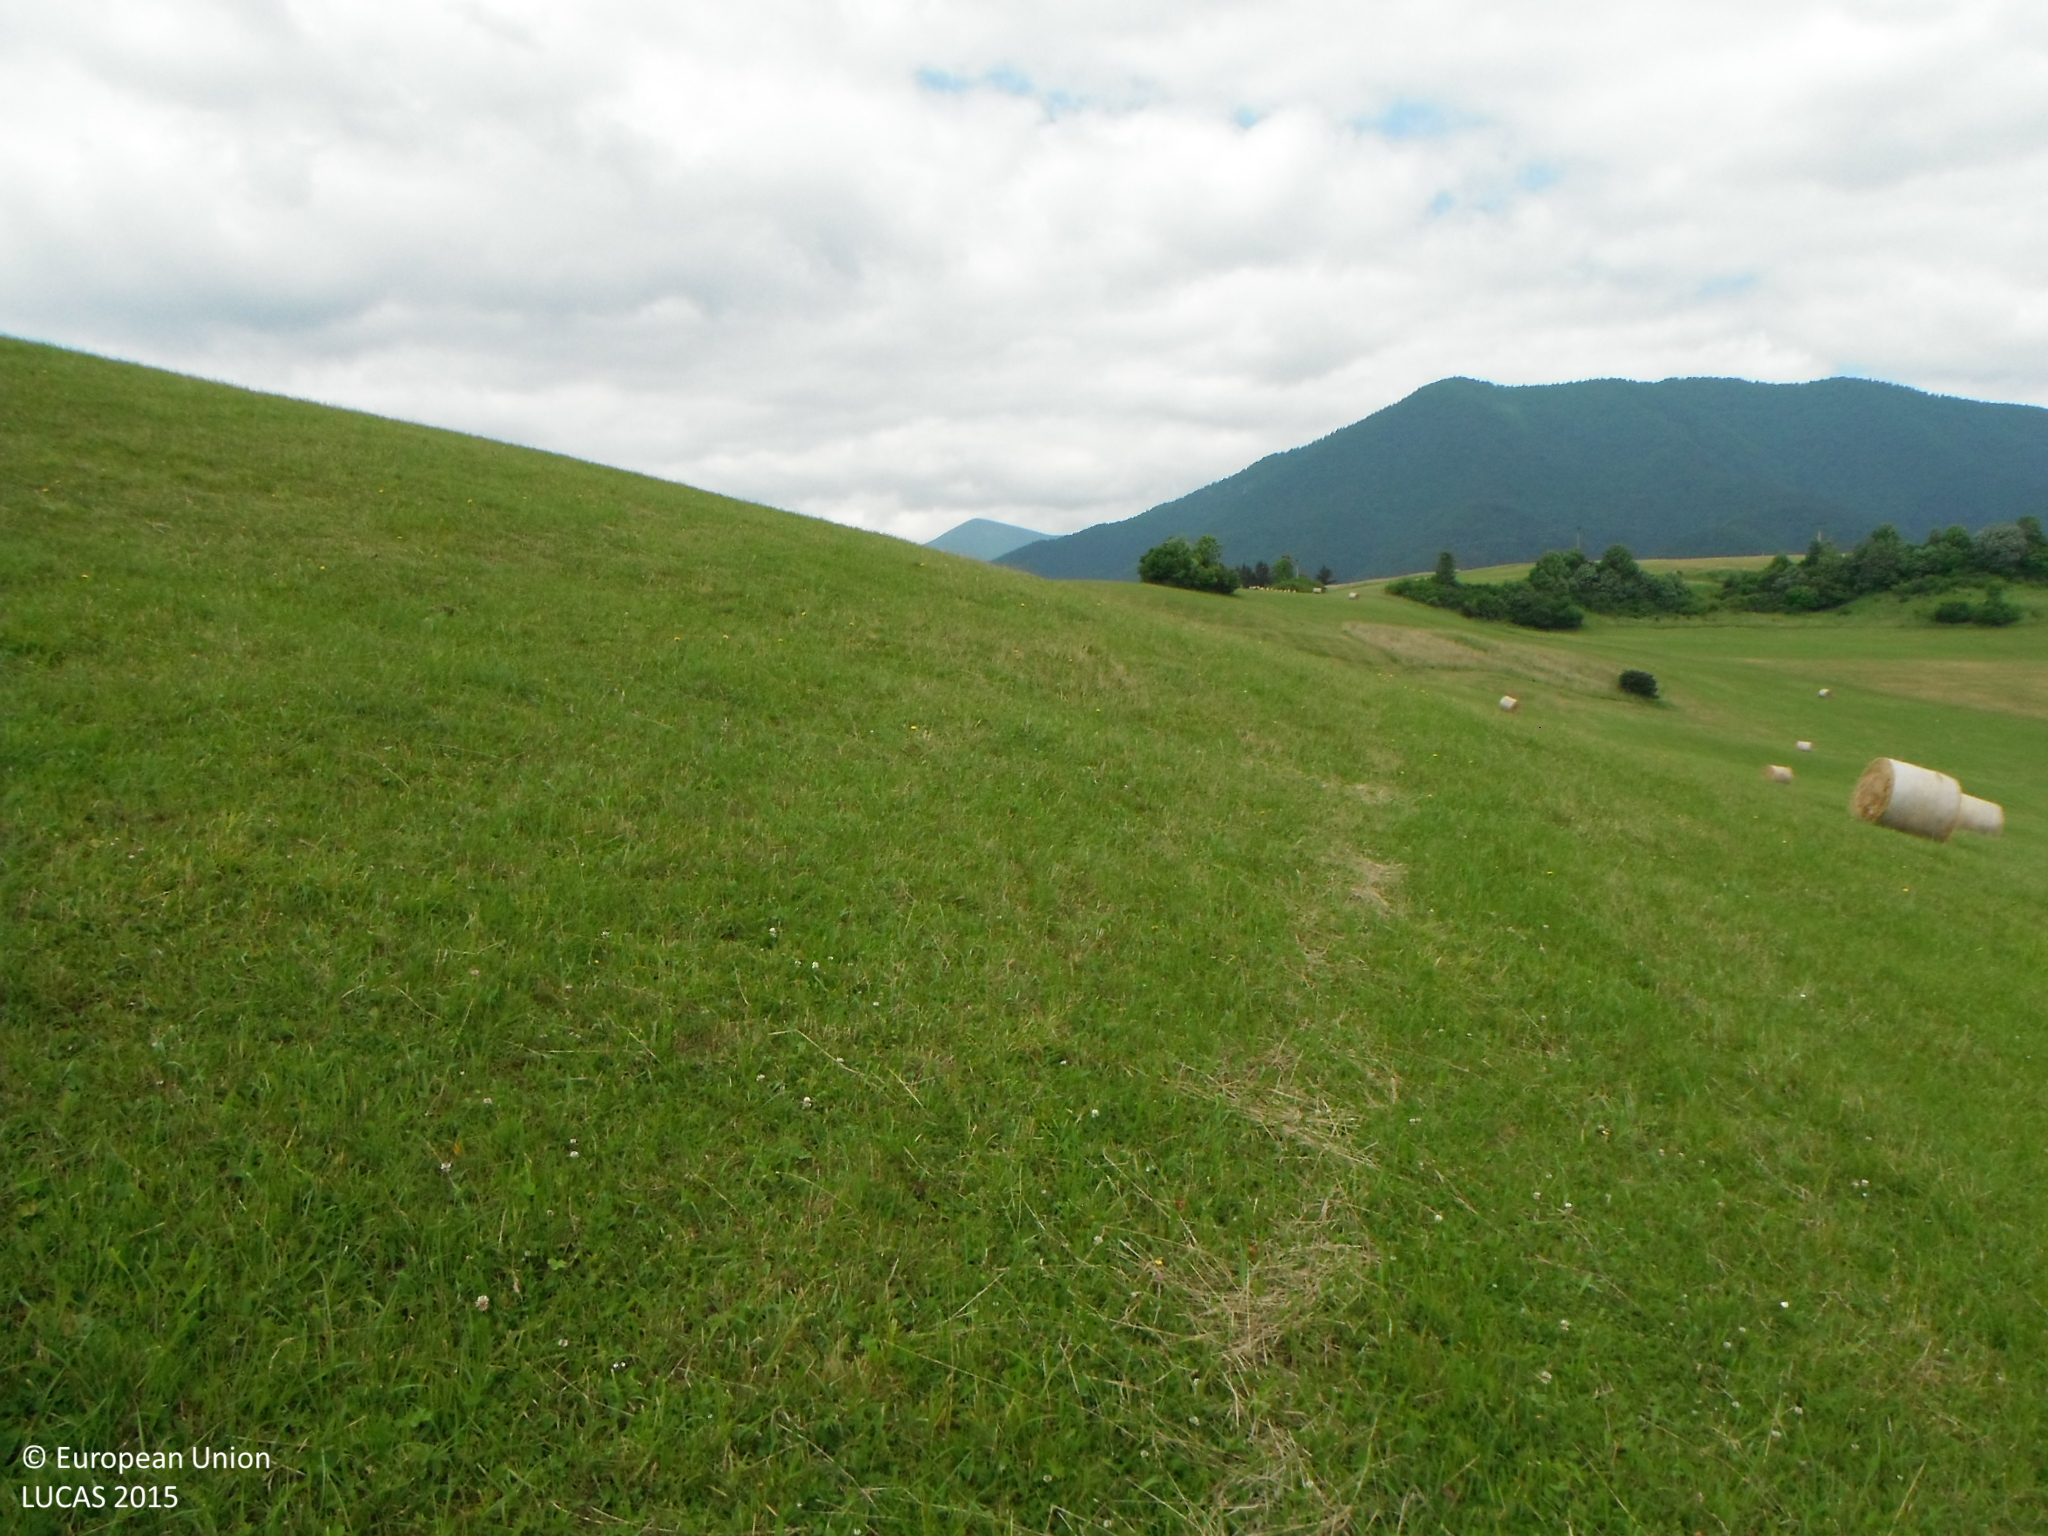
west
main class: Grassland
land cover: Grassland without tree/shrub cover
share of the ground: > 75 %
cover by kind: herbaceous plants 100 %
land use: Agriculture (excluding fallow land and kitchen gardens)
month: June
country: SK
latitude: 49.2114
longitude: 19.2349
